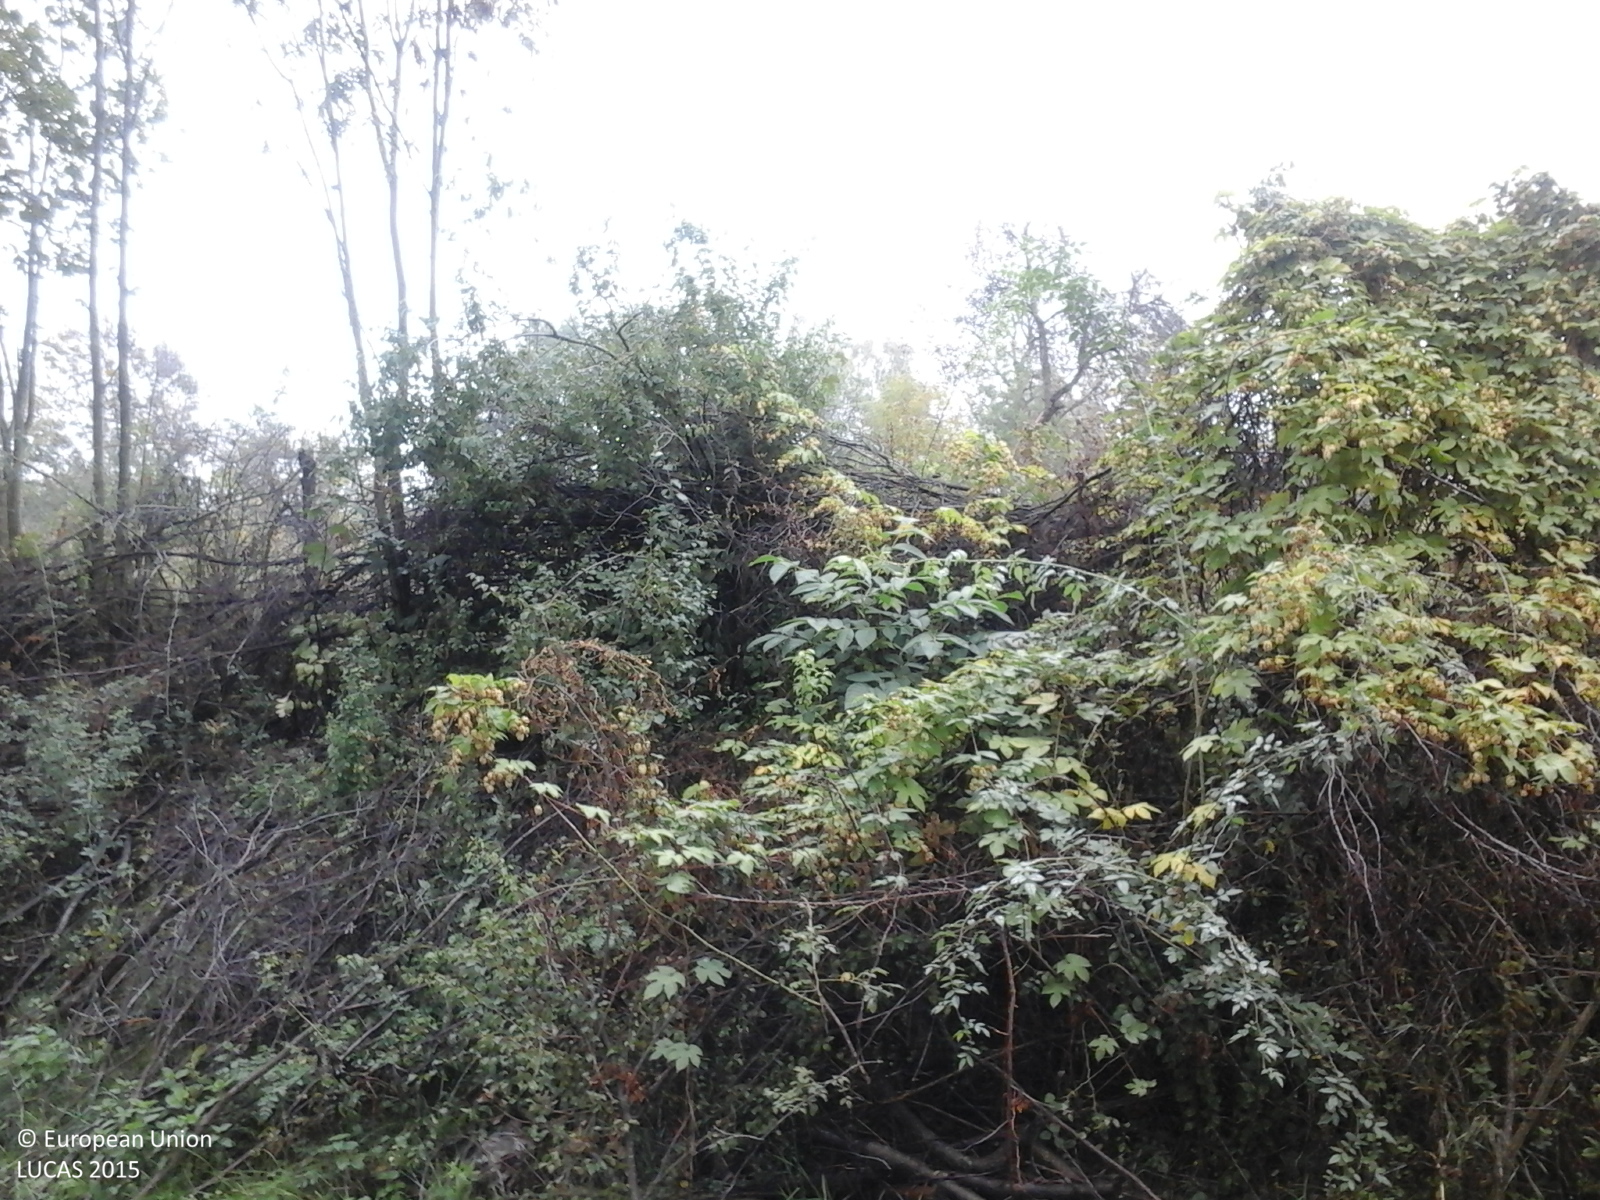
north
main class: Grassland
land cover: Grassland with sparse tree/shrub cover
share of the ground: > 75 %
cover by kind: herbaceous plants 95 %, broadleaved forest trees 5 %
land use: Agriculture (excluding fallow land and kitchen gardens)
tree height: > 5 m
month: October
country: RO
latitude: 45.7209
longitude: 24.9032
